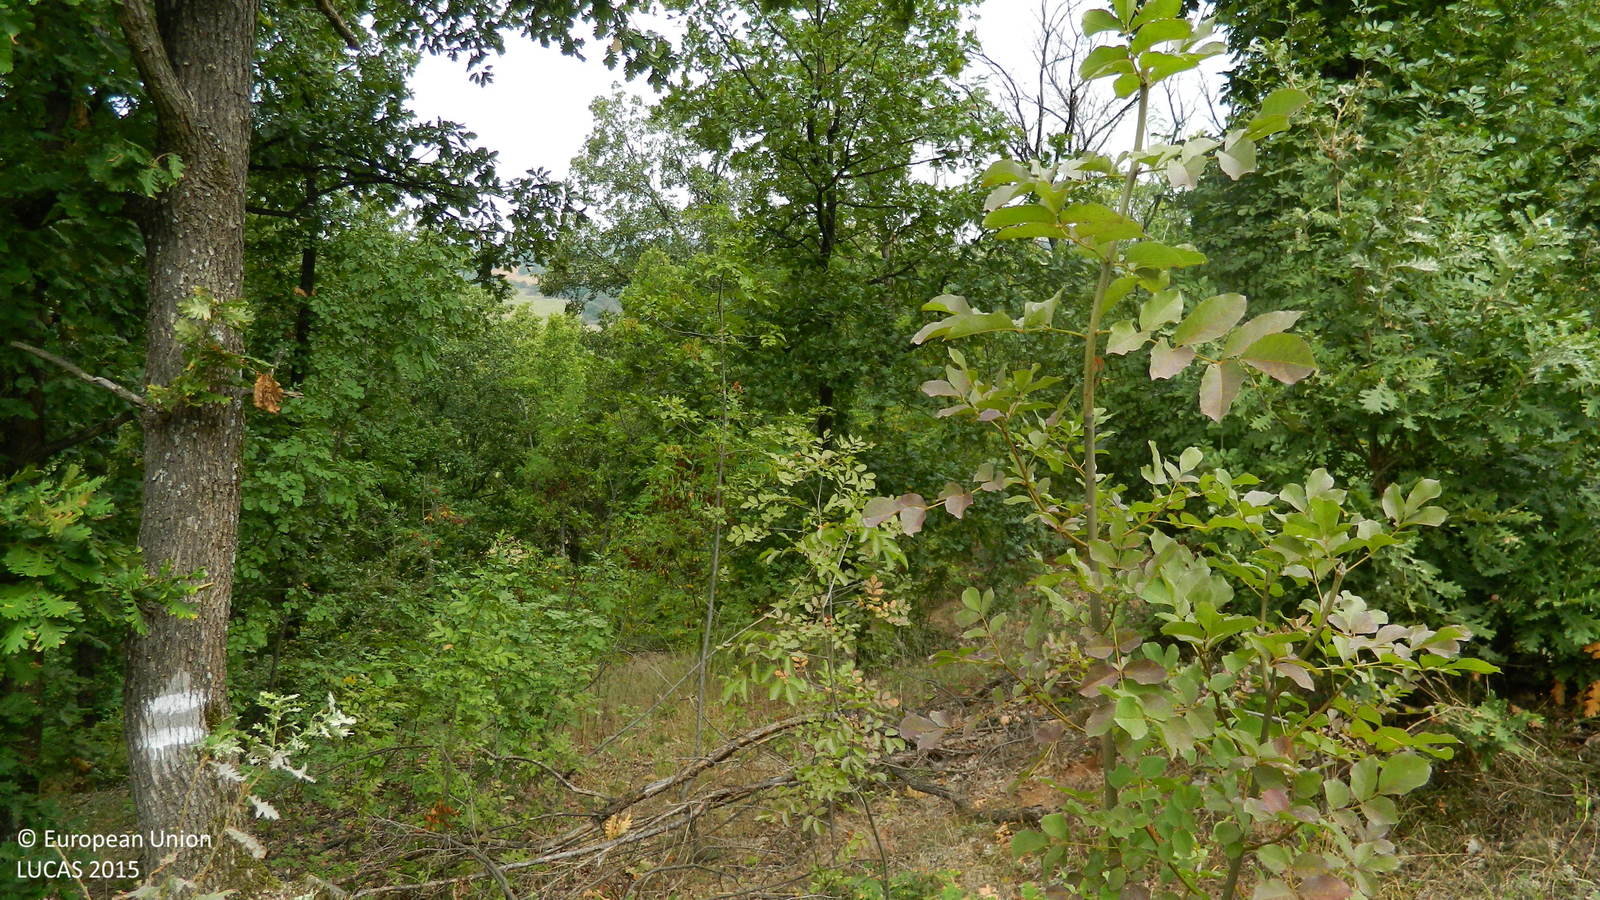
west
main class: Woodland
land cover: Broadleaved woodland
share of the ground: > 75 %
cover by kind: broadleaved forest trees 90 %, herbaceous plants 10 %
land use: Forestry
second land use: Electricity, gas and thermal power distribution
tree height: < 5 m
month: September
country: BG
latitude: 41.7913
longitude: 25.7952
